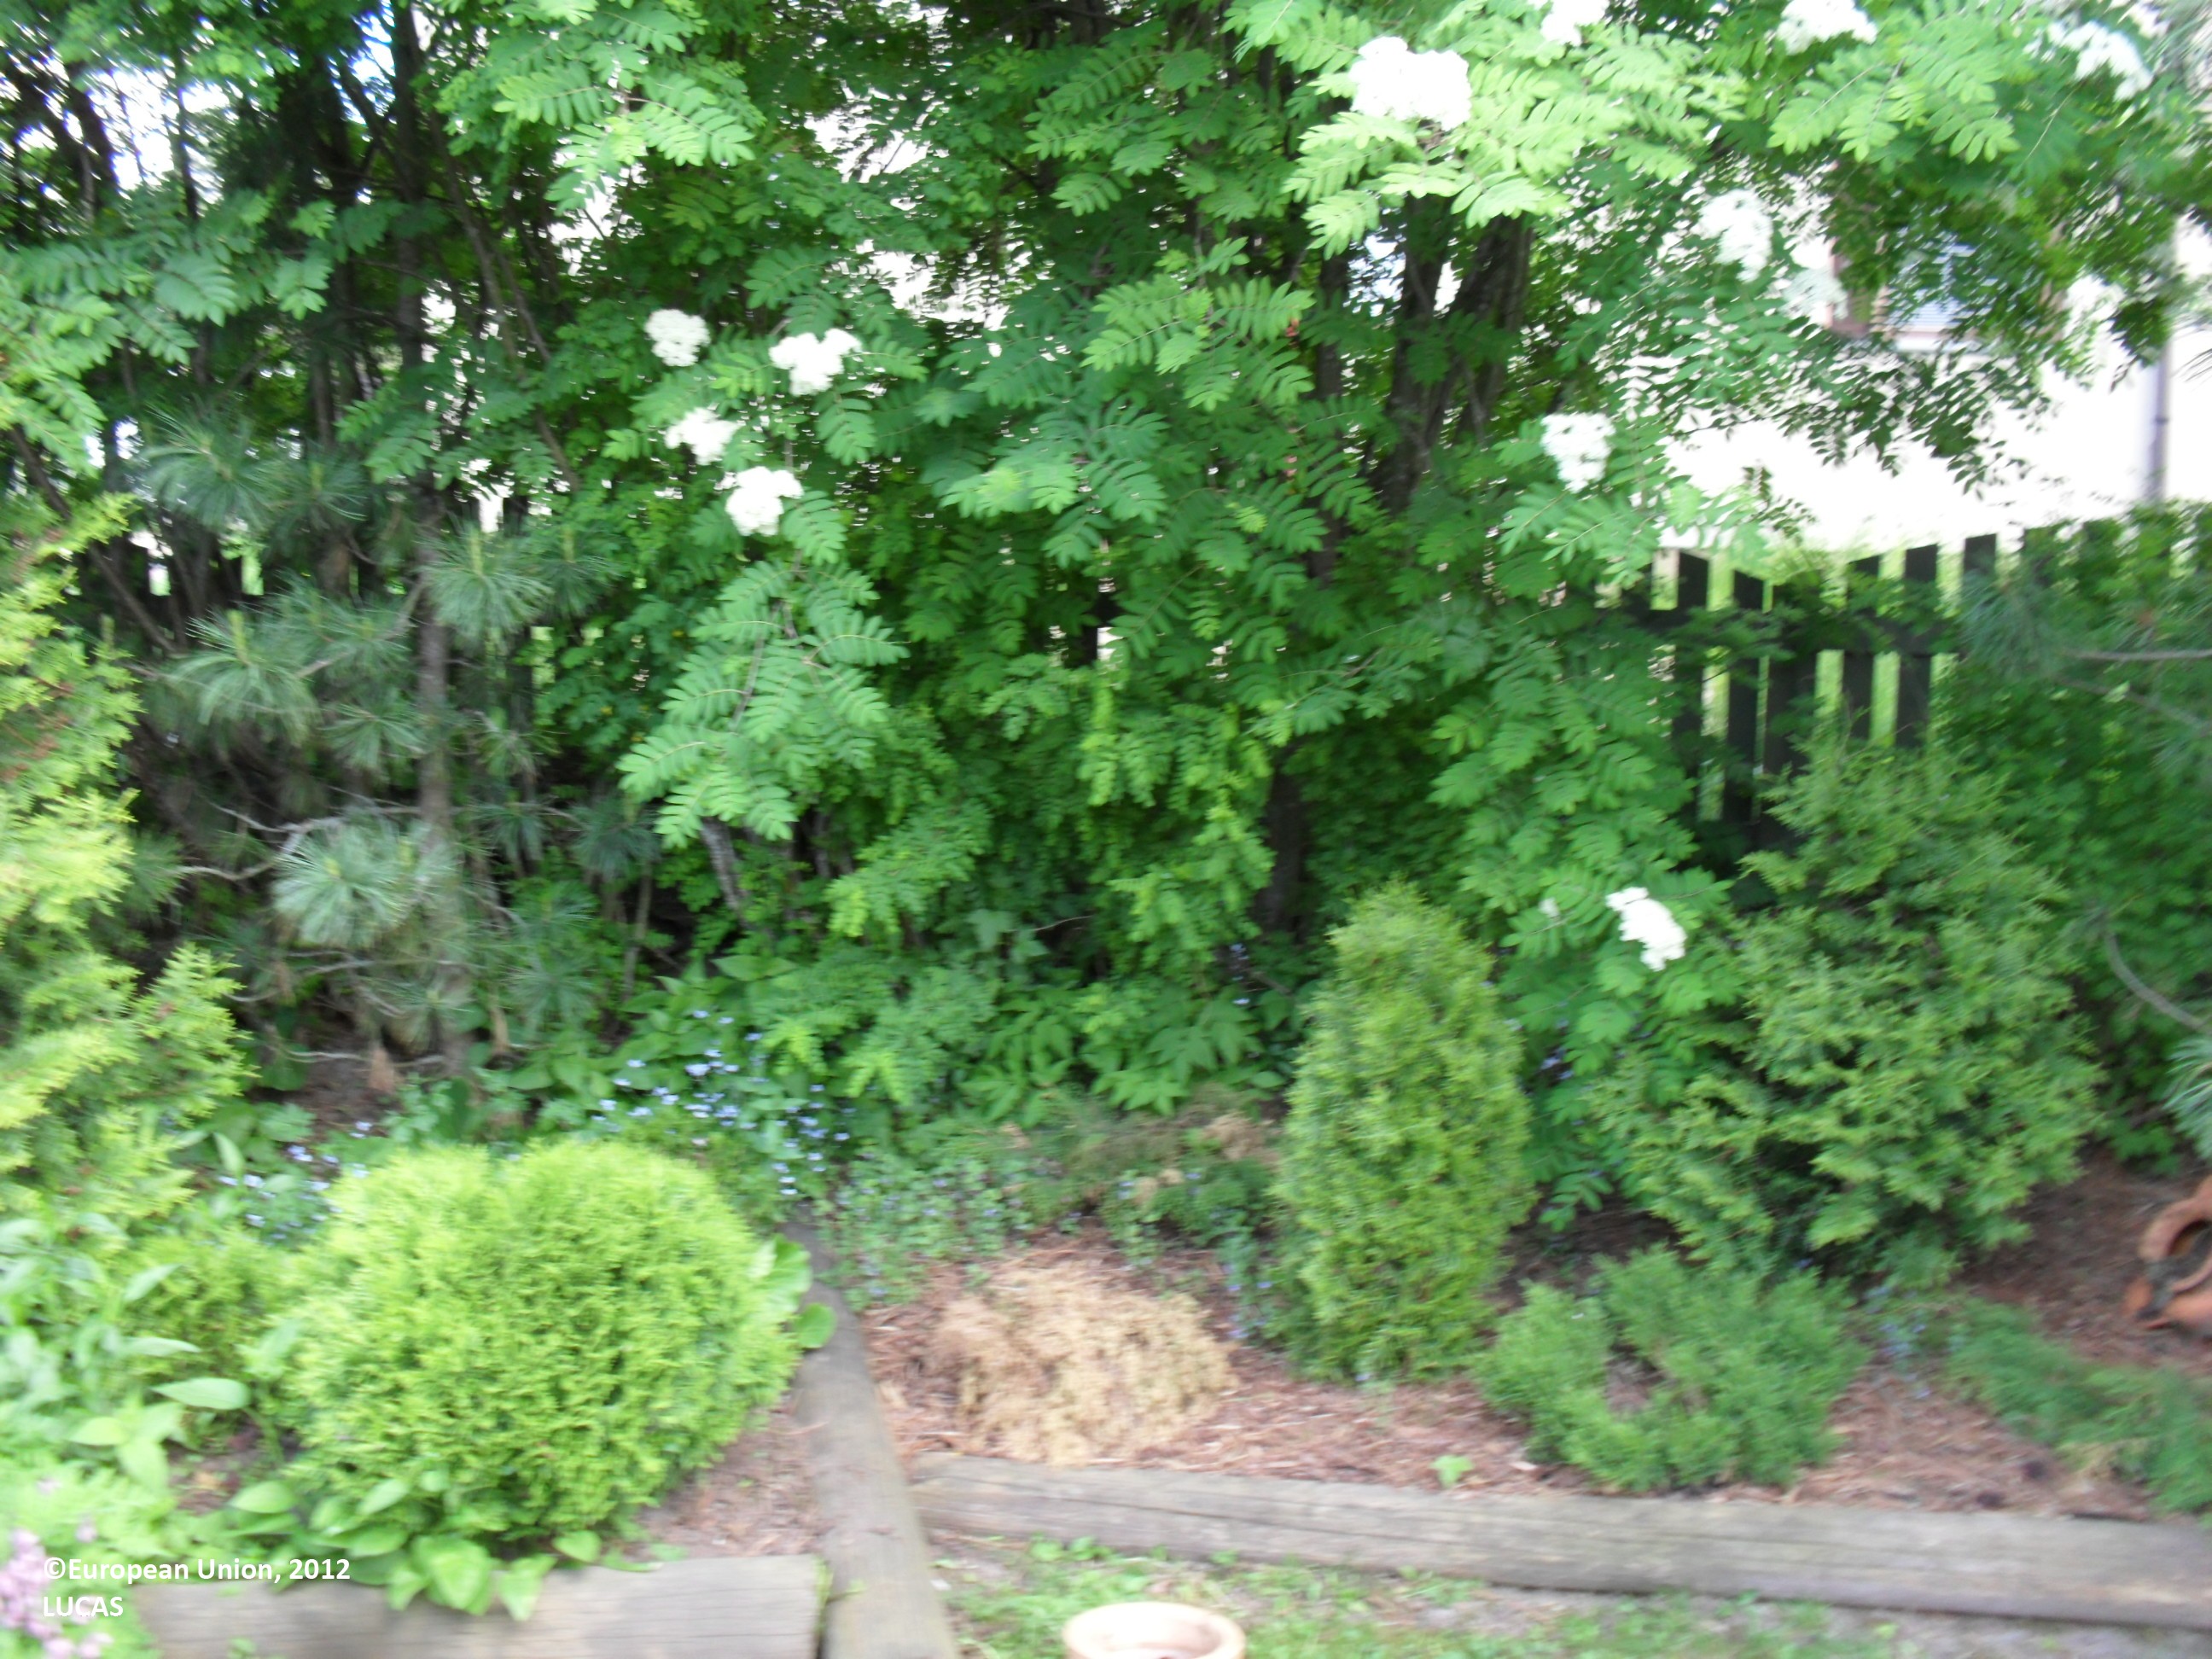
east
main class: Grassland
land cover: Grassland without tree/shrub cover
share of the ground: > 75 %
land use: Residential
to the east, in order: Grassland without tree/shrub cover; Artificial constructions in urban areas
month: June
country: FI
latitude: 62.8076
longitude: 23.5045
